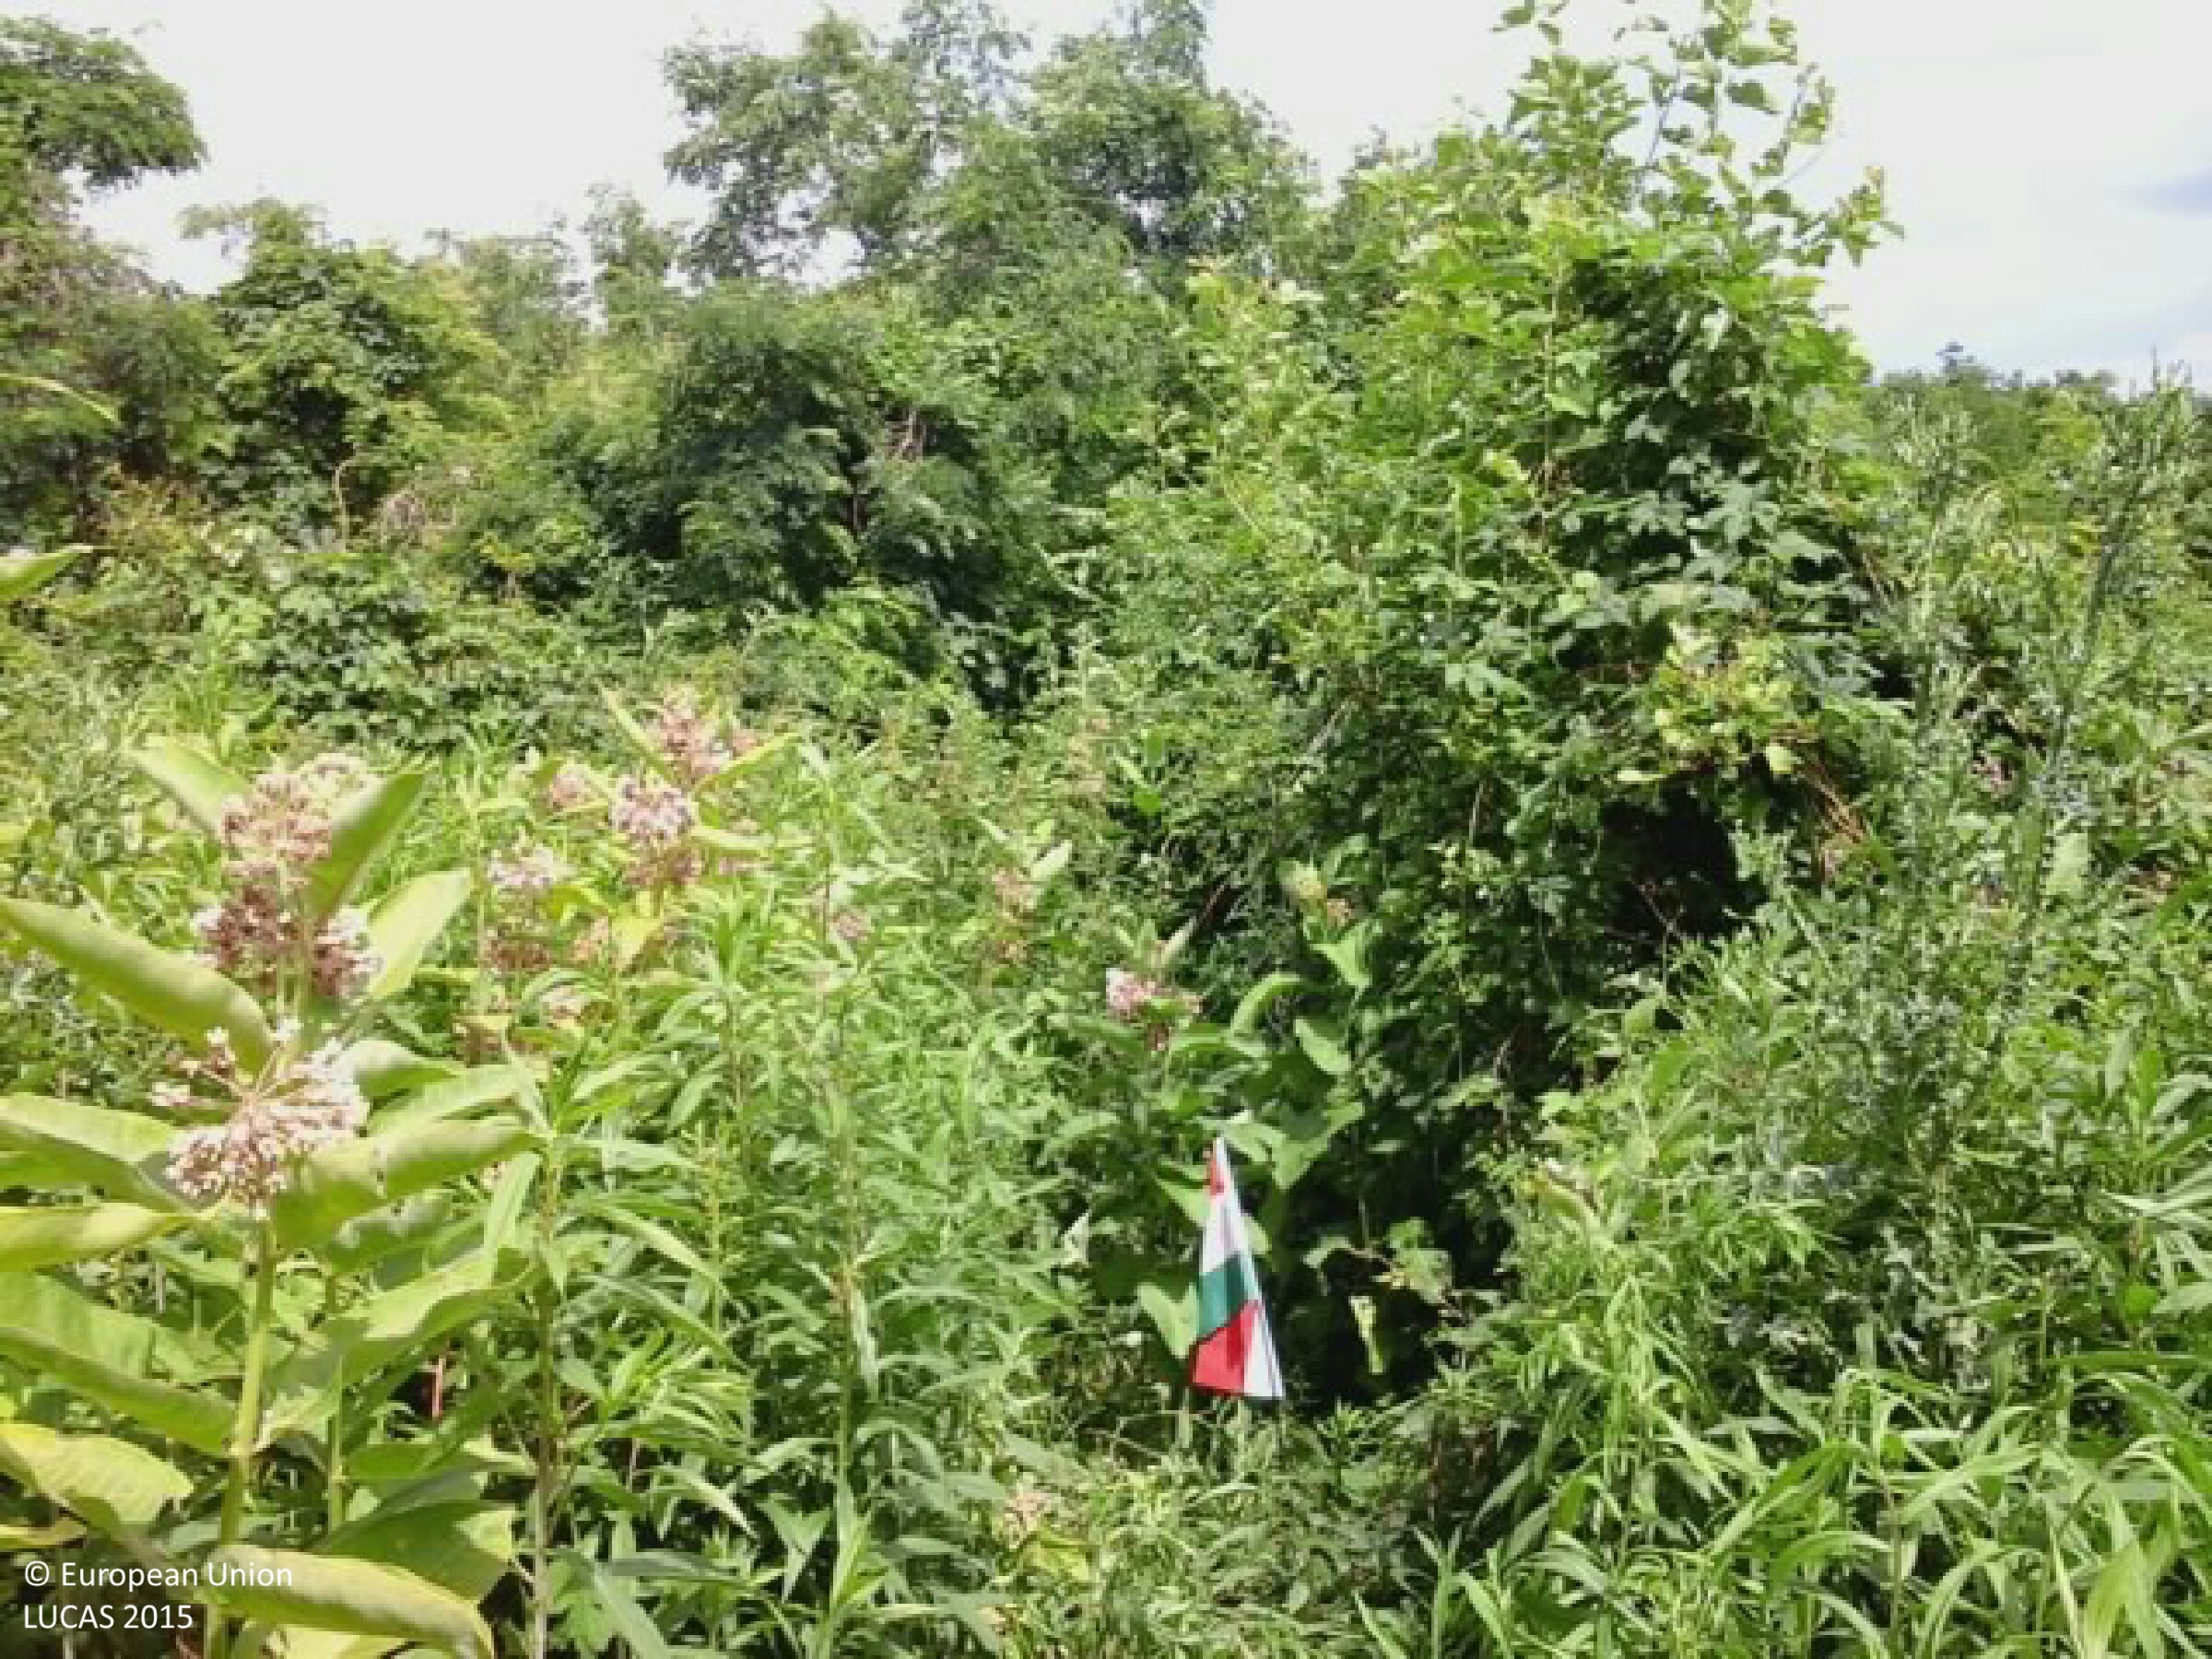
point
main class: Shrubland
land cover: Shrubland with sparse tree cover
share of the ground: > 75 %
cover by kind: shrubs 65 %, herbaceous plants 30 %, broadleaved forest trees 5 %
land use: Semi-natural and natural areas not in use
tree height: > 5 m
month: June
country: HU
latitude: 47.5371
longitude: 19.3327
